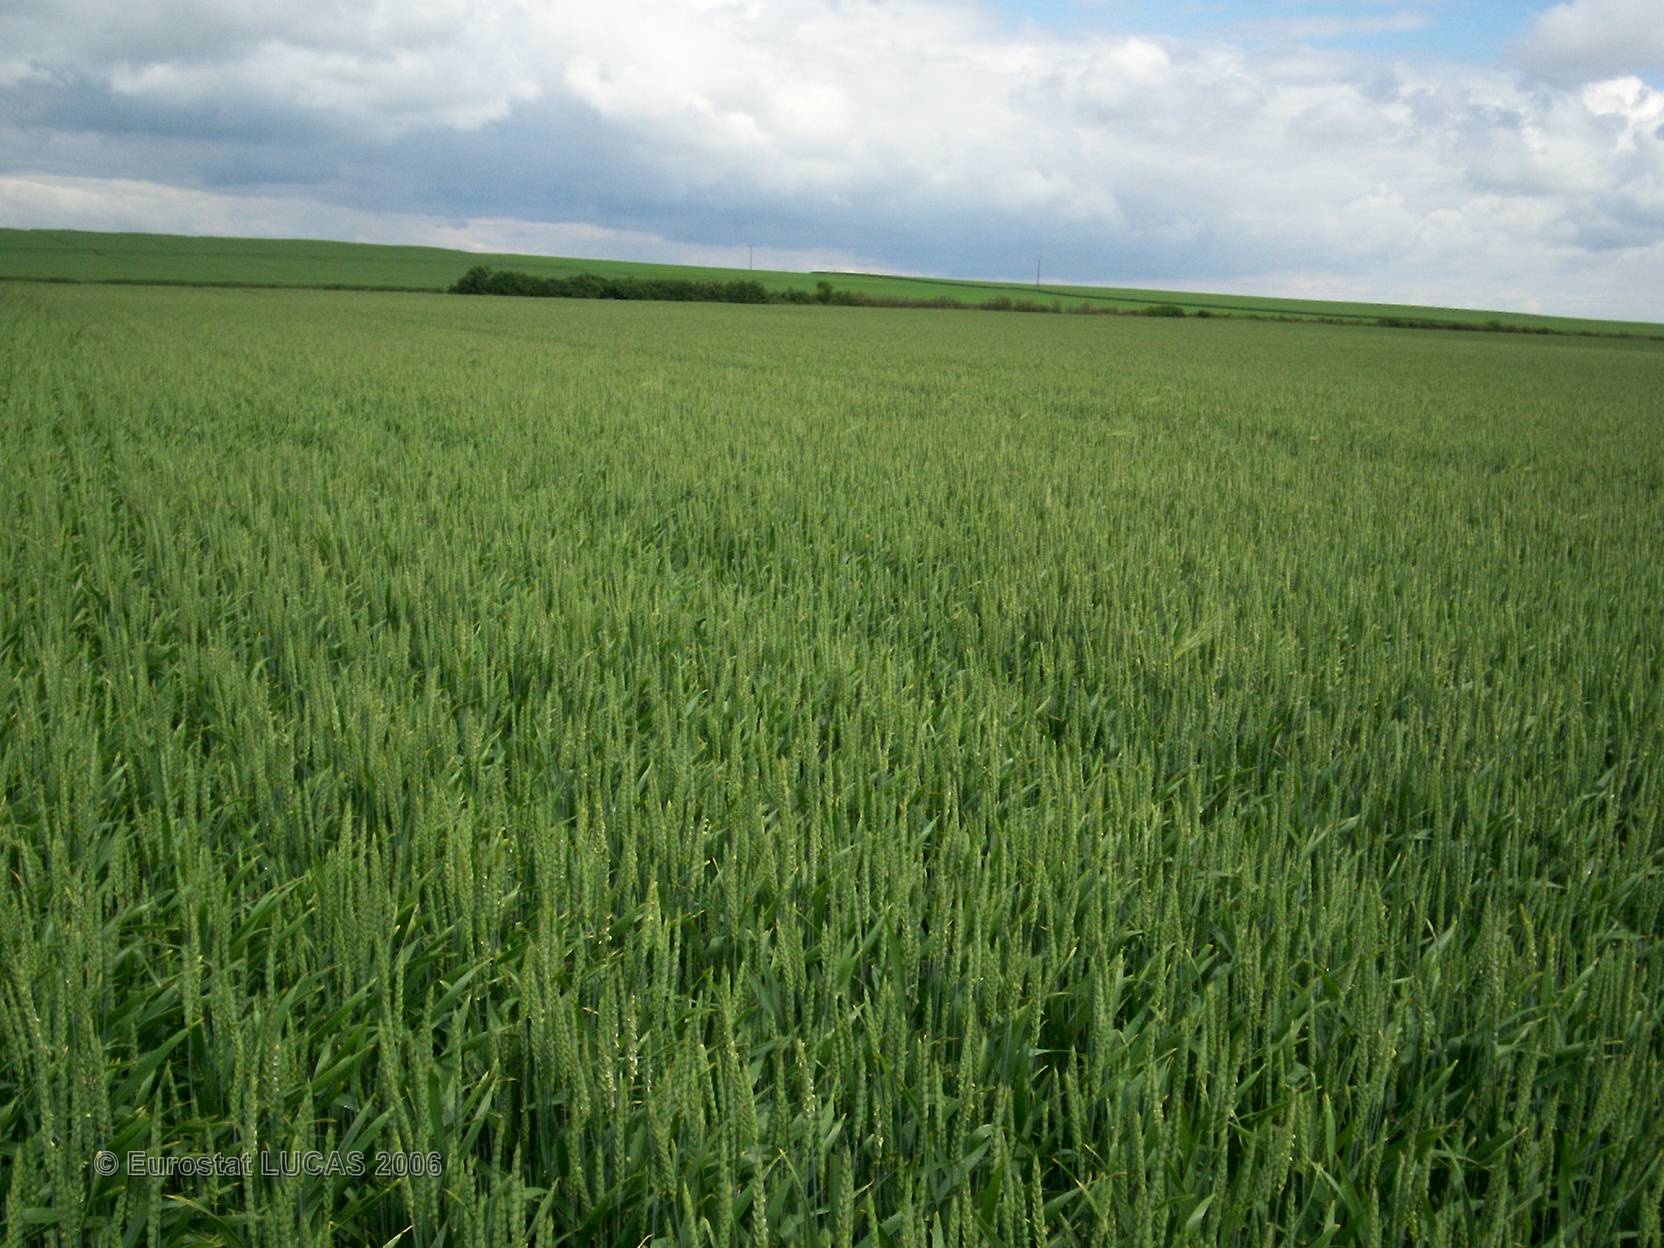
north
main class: Cropland
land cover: Common wheat
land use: Agriculture (excluding fallow land and kitchen gardens)
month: May
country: FR
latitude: 48.2946
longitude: 3.9978
